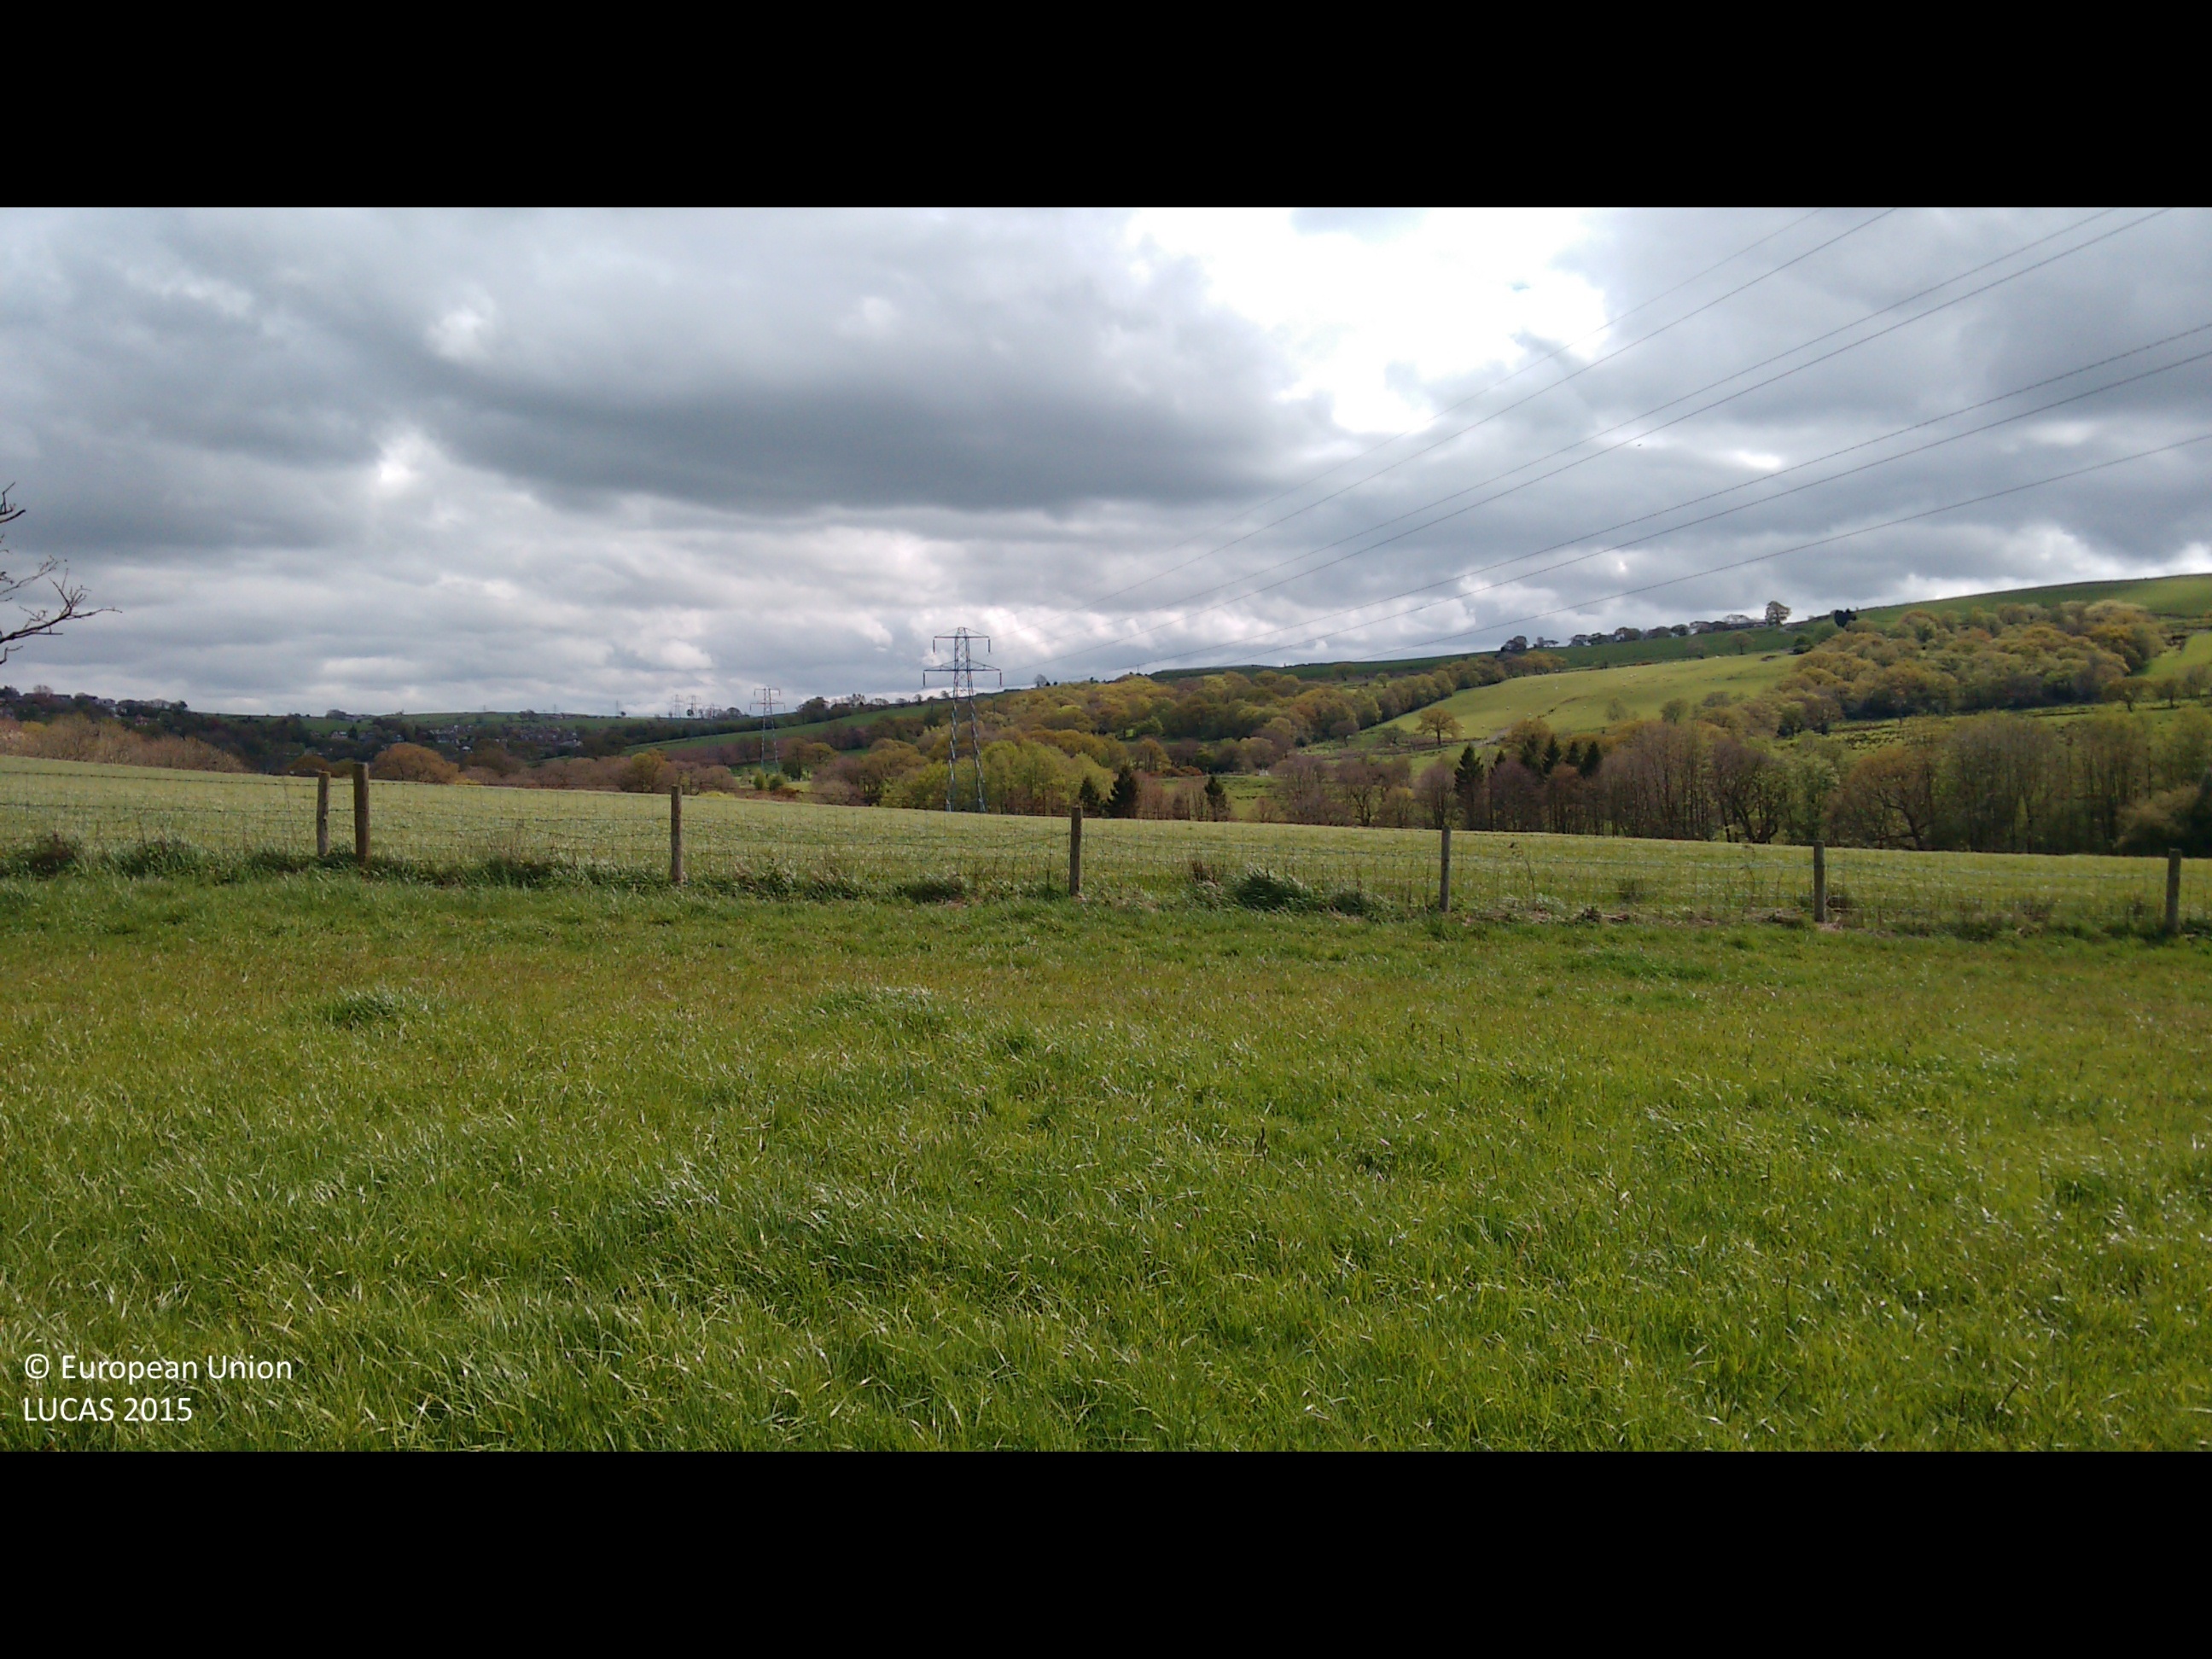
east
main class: Grassland
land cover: Grassland without tree/shrub cover
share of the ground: > 75 %
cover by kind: herbaceous plants 100 %
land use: Agriculture (excluding fallow land and kitchen gardens)
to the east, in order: Grassland without tree/shrub cover; Fences; Grassland without tree/shrub cover
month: May
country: GB
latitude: 53.7891
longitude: -2.4966
